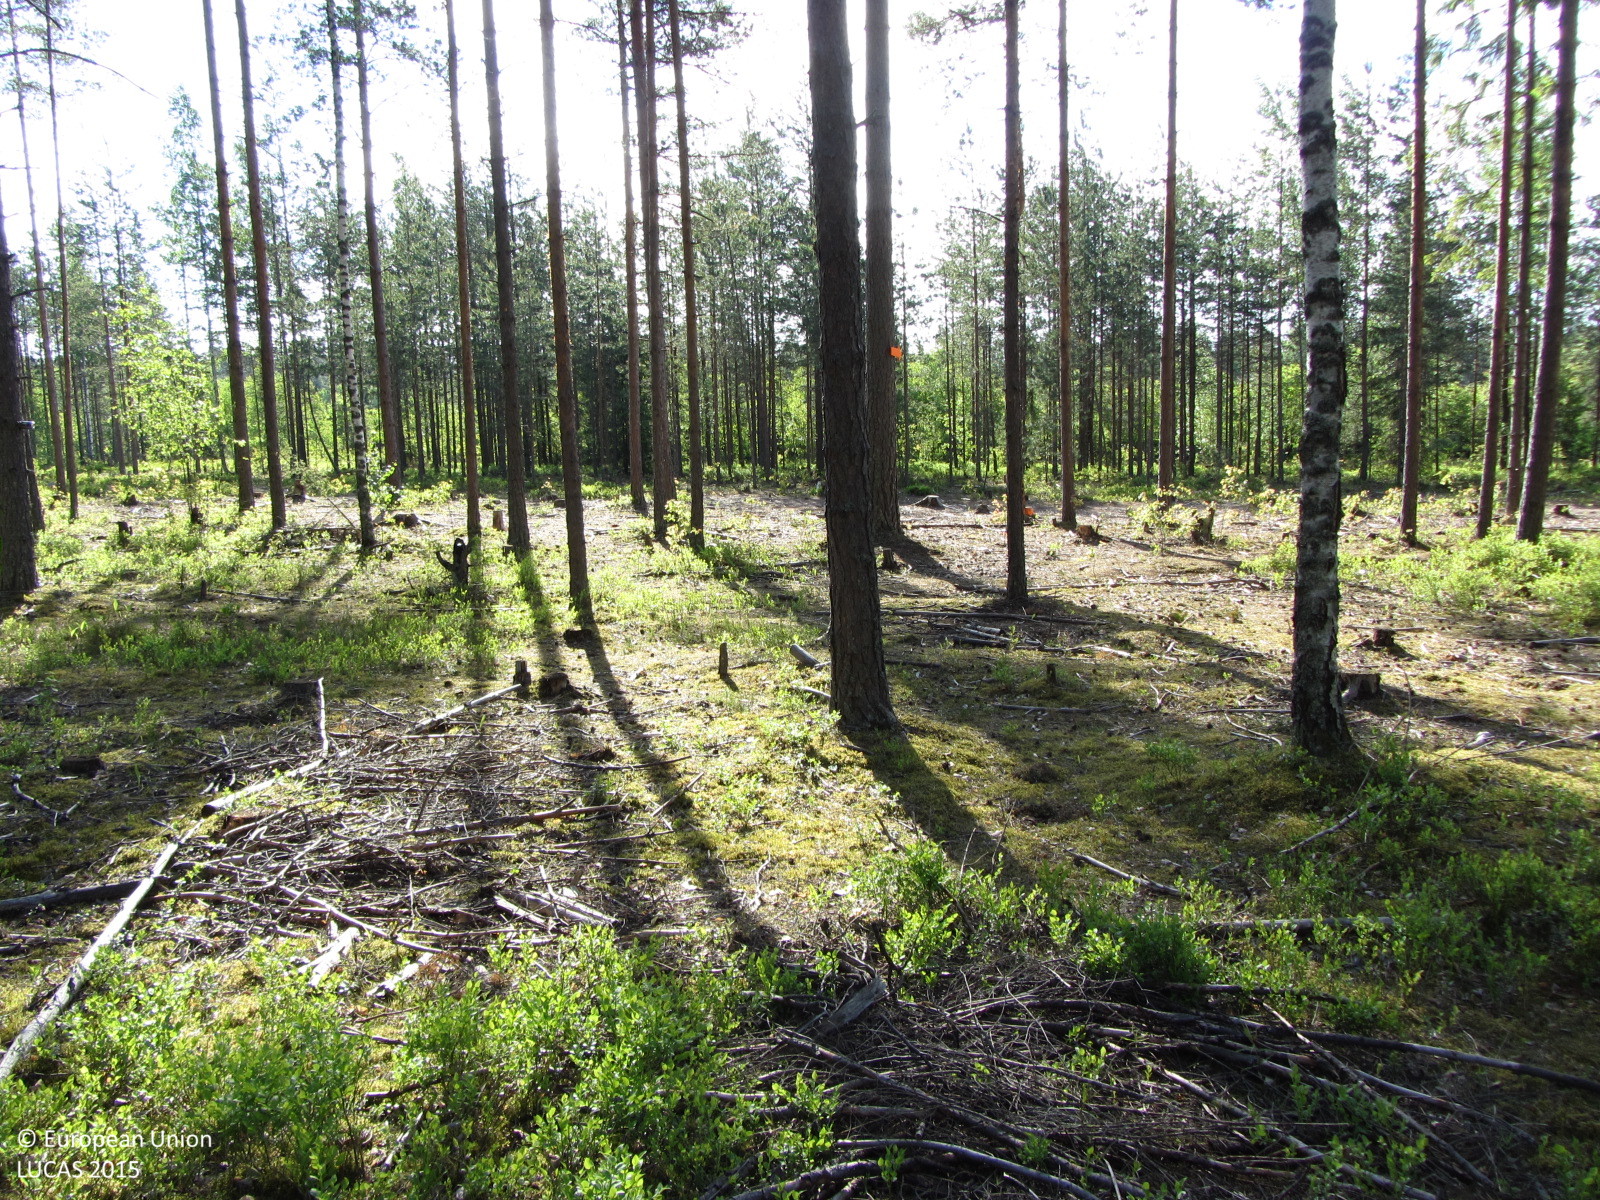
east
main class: Woodland
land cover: Other mixed woodland
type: boreal forest
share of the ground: > 75 %
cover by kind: coniferous forest trees 55 %, broadleaved forest trees 30 %, shrubs 5 %, lichens and mosses 5 %, unconsolidated bare surface 5 %
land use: Forestry
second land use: Amenities, museums, leisure
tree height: > 5 m
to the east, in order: Other mixed woodland; Other bare soil; Spruce dominated mixed woodland; Tracks; Spruce dominated mixed woodland; Broadleaved woodland; Tracks; Shrubland without tree cover; Grassland without tree/shrub cover; Artificial constructions in urban areas; Grassland without tree/shrub cover
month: June
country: FI
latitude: 60.3288
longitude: 24.2833
